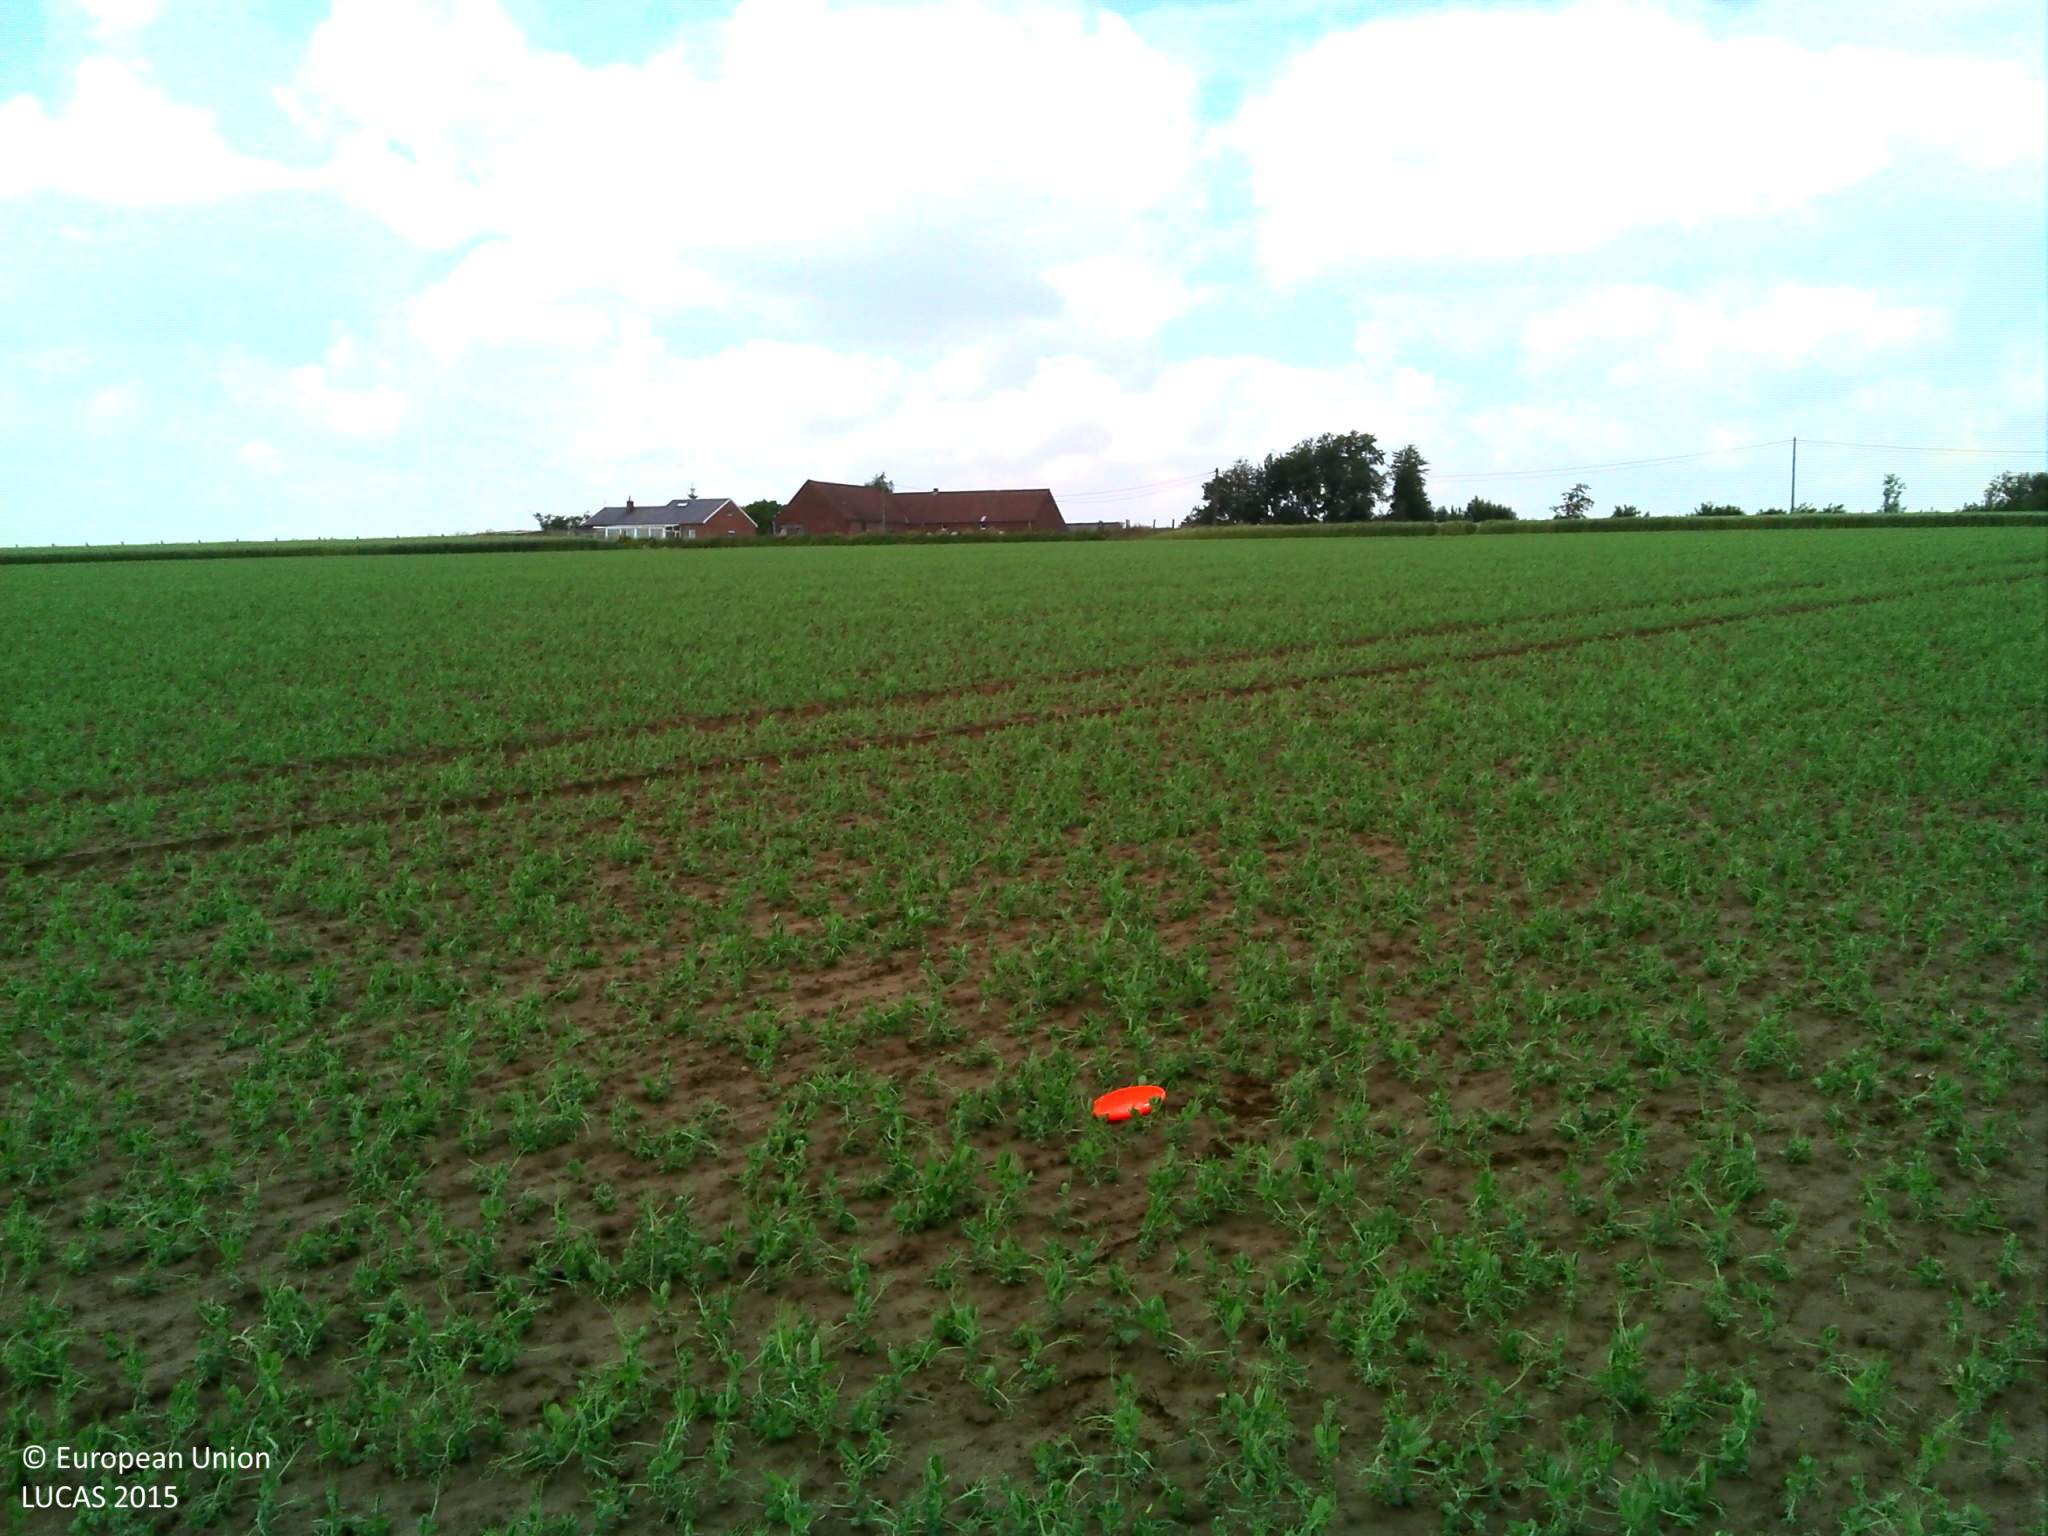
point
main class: Cropland
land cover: Dry pulses
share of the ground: 25 - 50 %
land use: Agriculture (excluding fallow land and kitchen gardens)
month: June
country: BE
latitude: 50.6295
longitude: 3.8156
